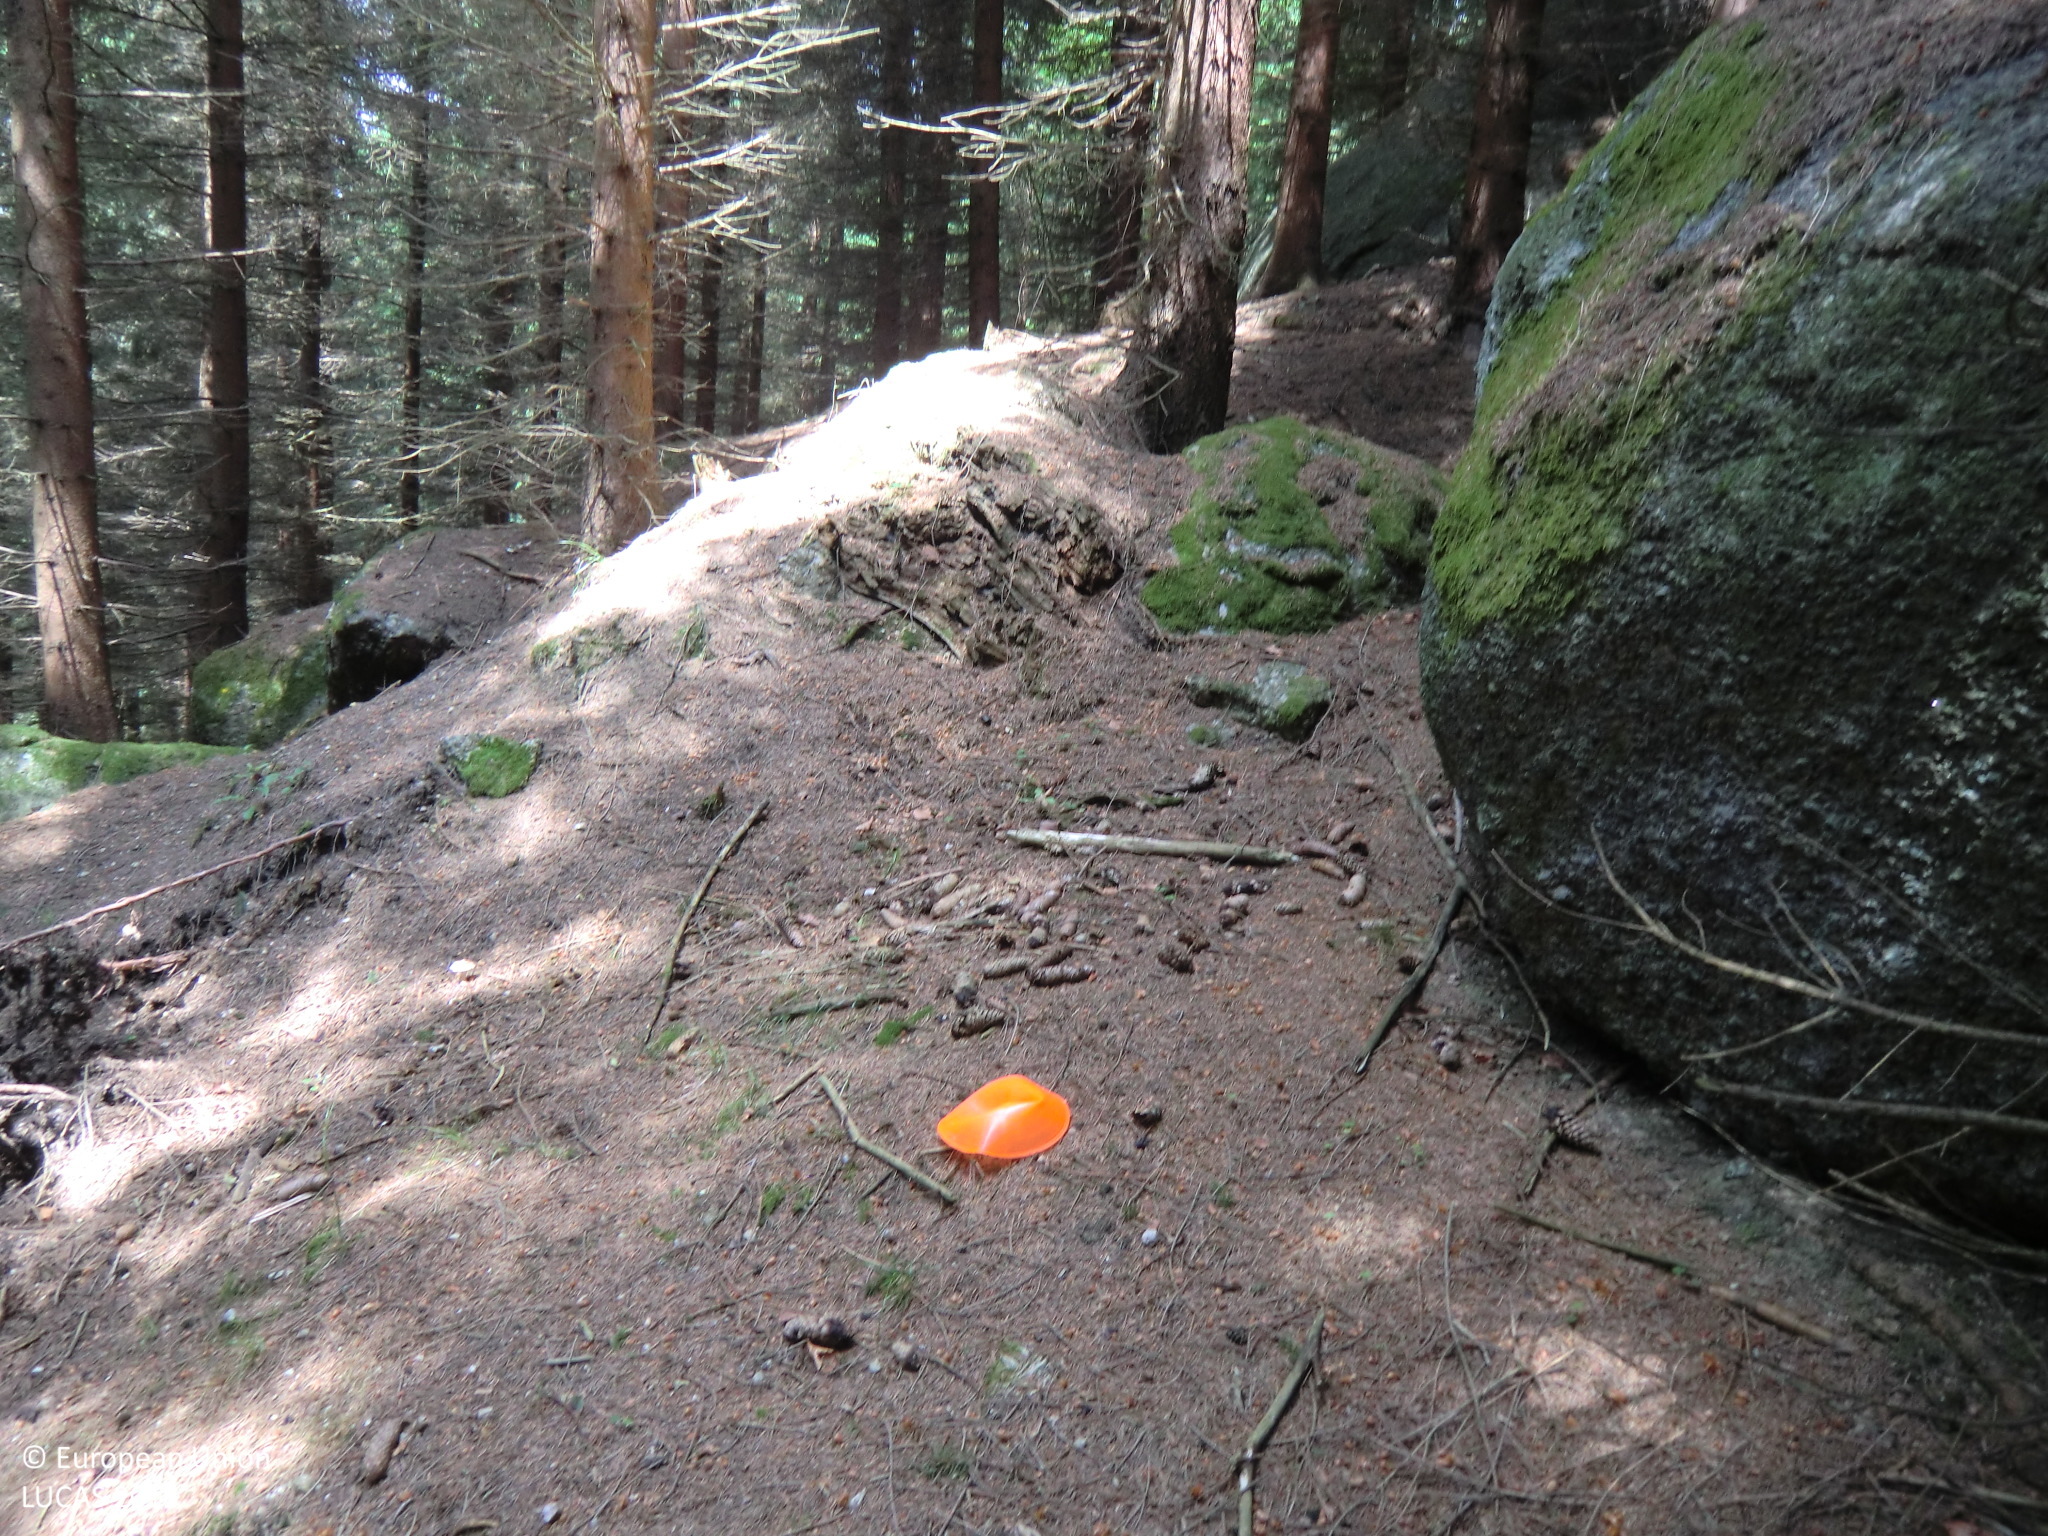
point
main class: Woodland
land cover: Spruce dominated coniferous woodland
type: hemiboreal forest and nemoral coniferous forest and mixed broadleaved-coniferous forest
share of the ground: > 75 %
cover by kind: coniferous forest trees 90 %, unconsolidated bare surface 10 %
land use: Forestry
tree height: > 5 m
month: June
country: AT
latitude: 48.4255
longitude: 14.7986
